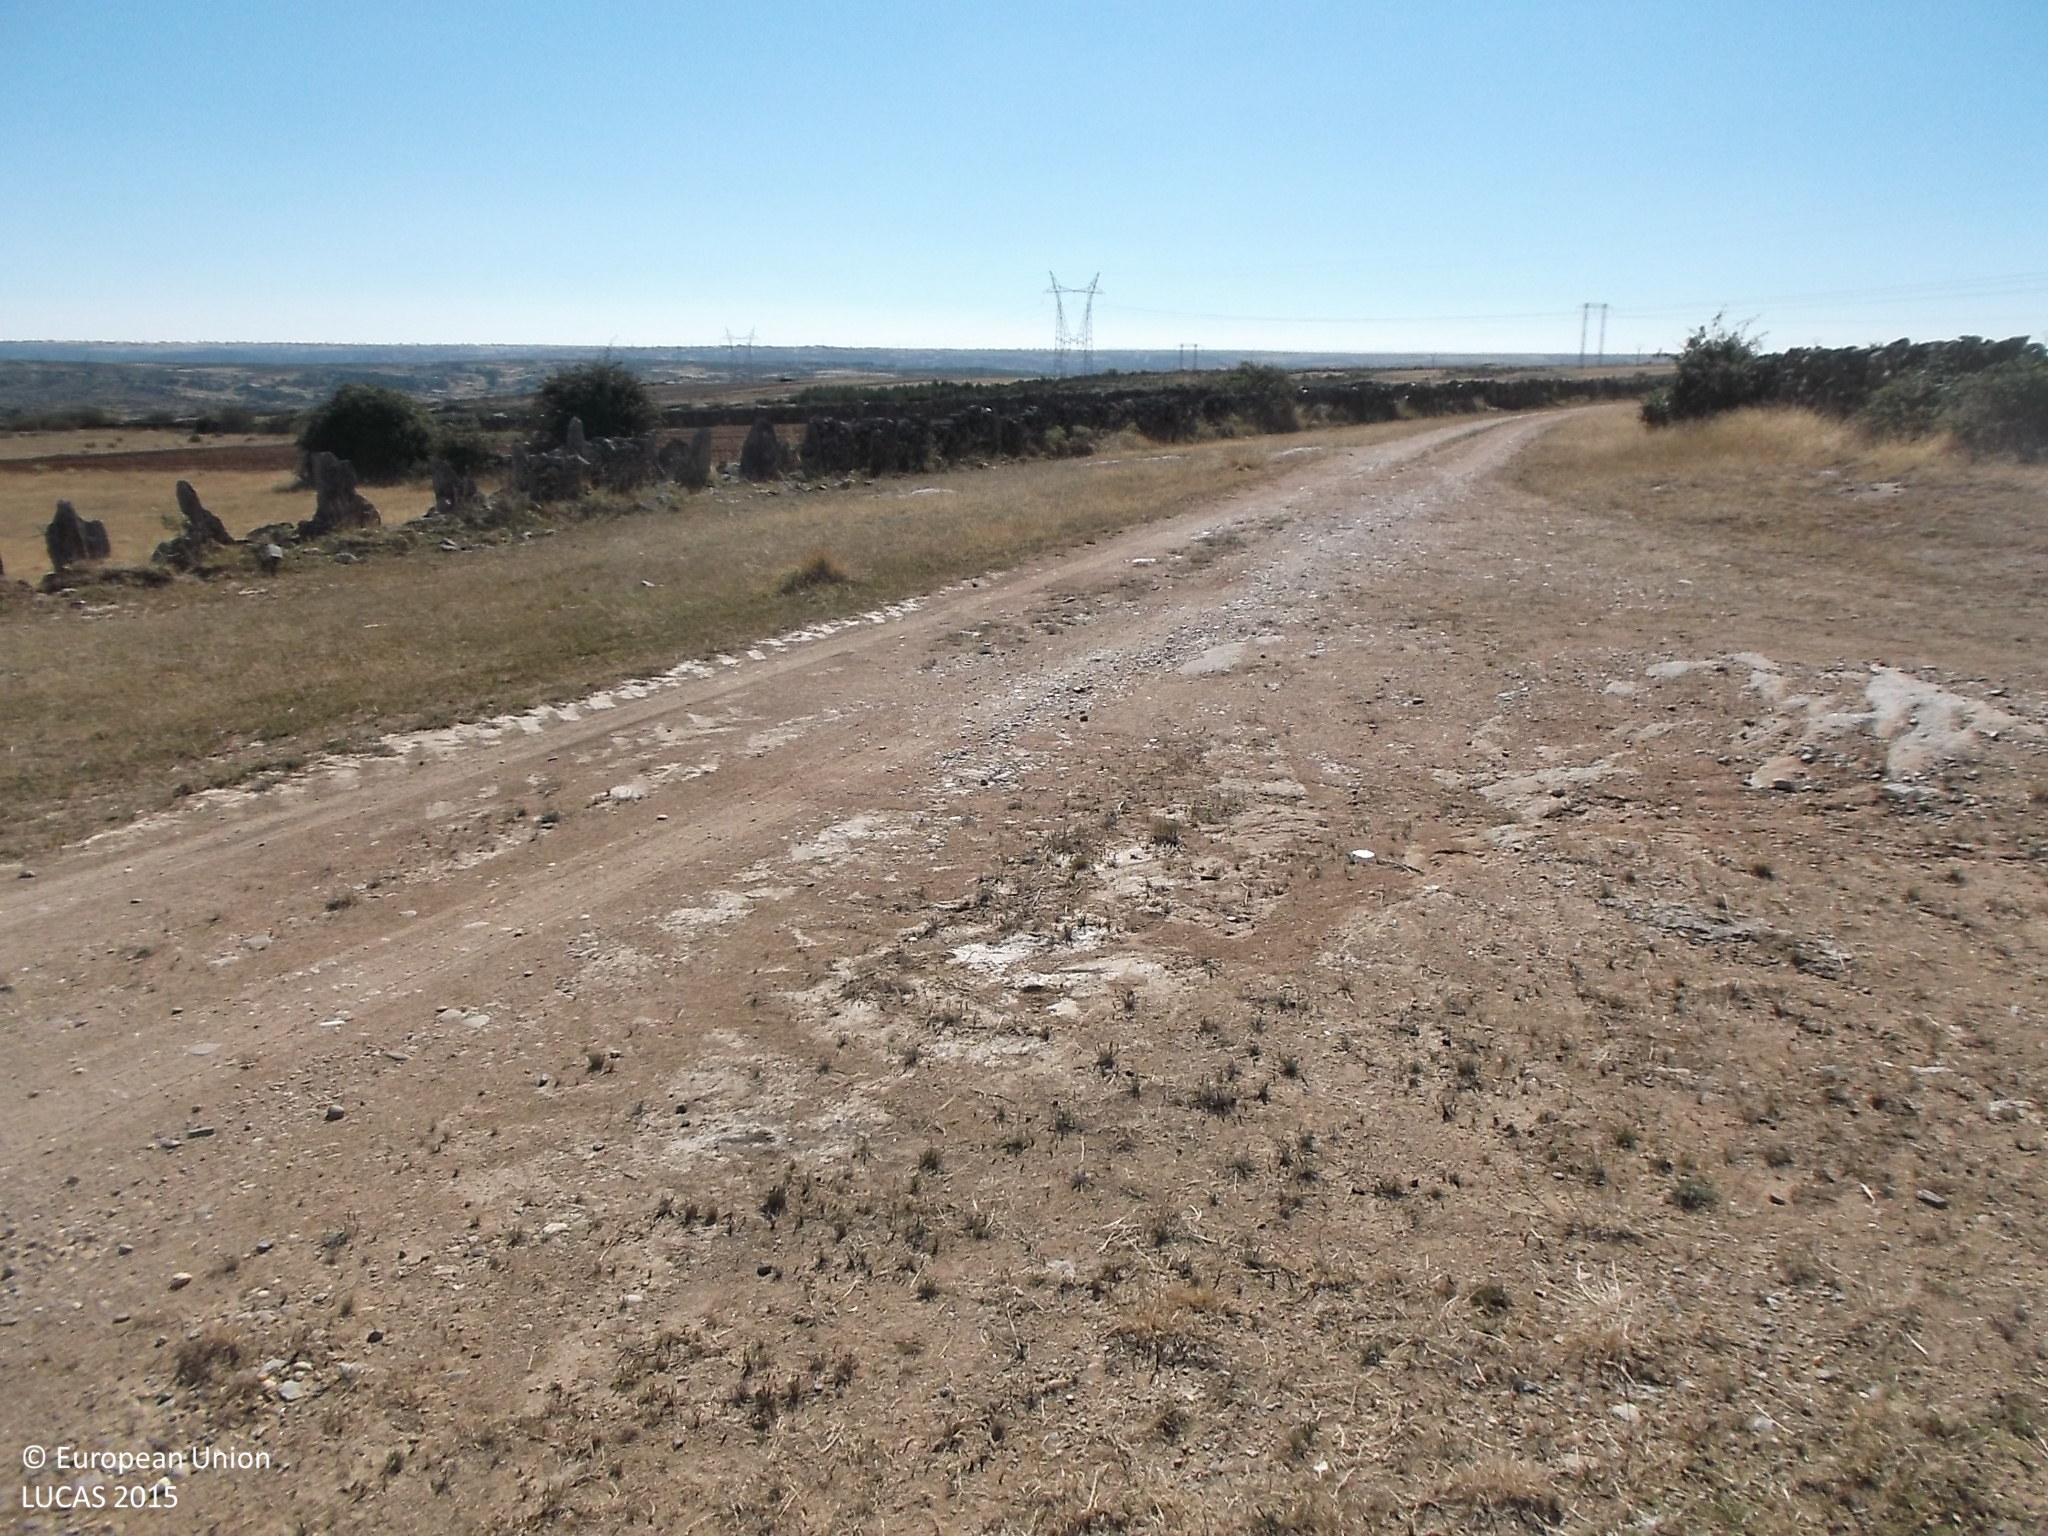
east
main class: Grassland
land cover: Grassland without tree/shrub cover
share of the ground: > 75 %
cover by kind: herbaceous plants 100 %
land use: Agriculture (excluding fallow land and kitchen gardens)
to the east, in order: Grassland without tree/shrub cover; Tracks; Grassland without tree/shrub cover; Dry stone walls; Grass margins; Other bare soil; Grass margins; Dry stone walls; Grassland without tree/shrub cover; Dry stone walls; Grassland without tree/shrub cover; Dry stone walls; Grassland without tree/shrub cover
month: July
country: ES
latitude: 41.5129
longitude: -6.0406
